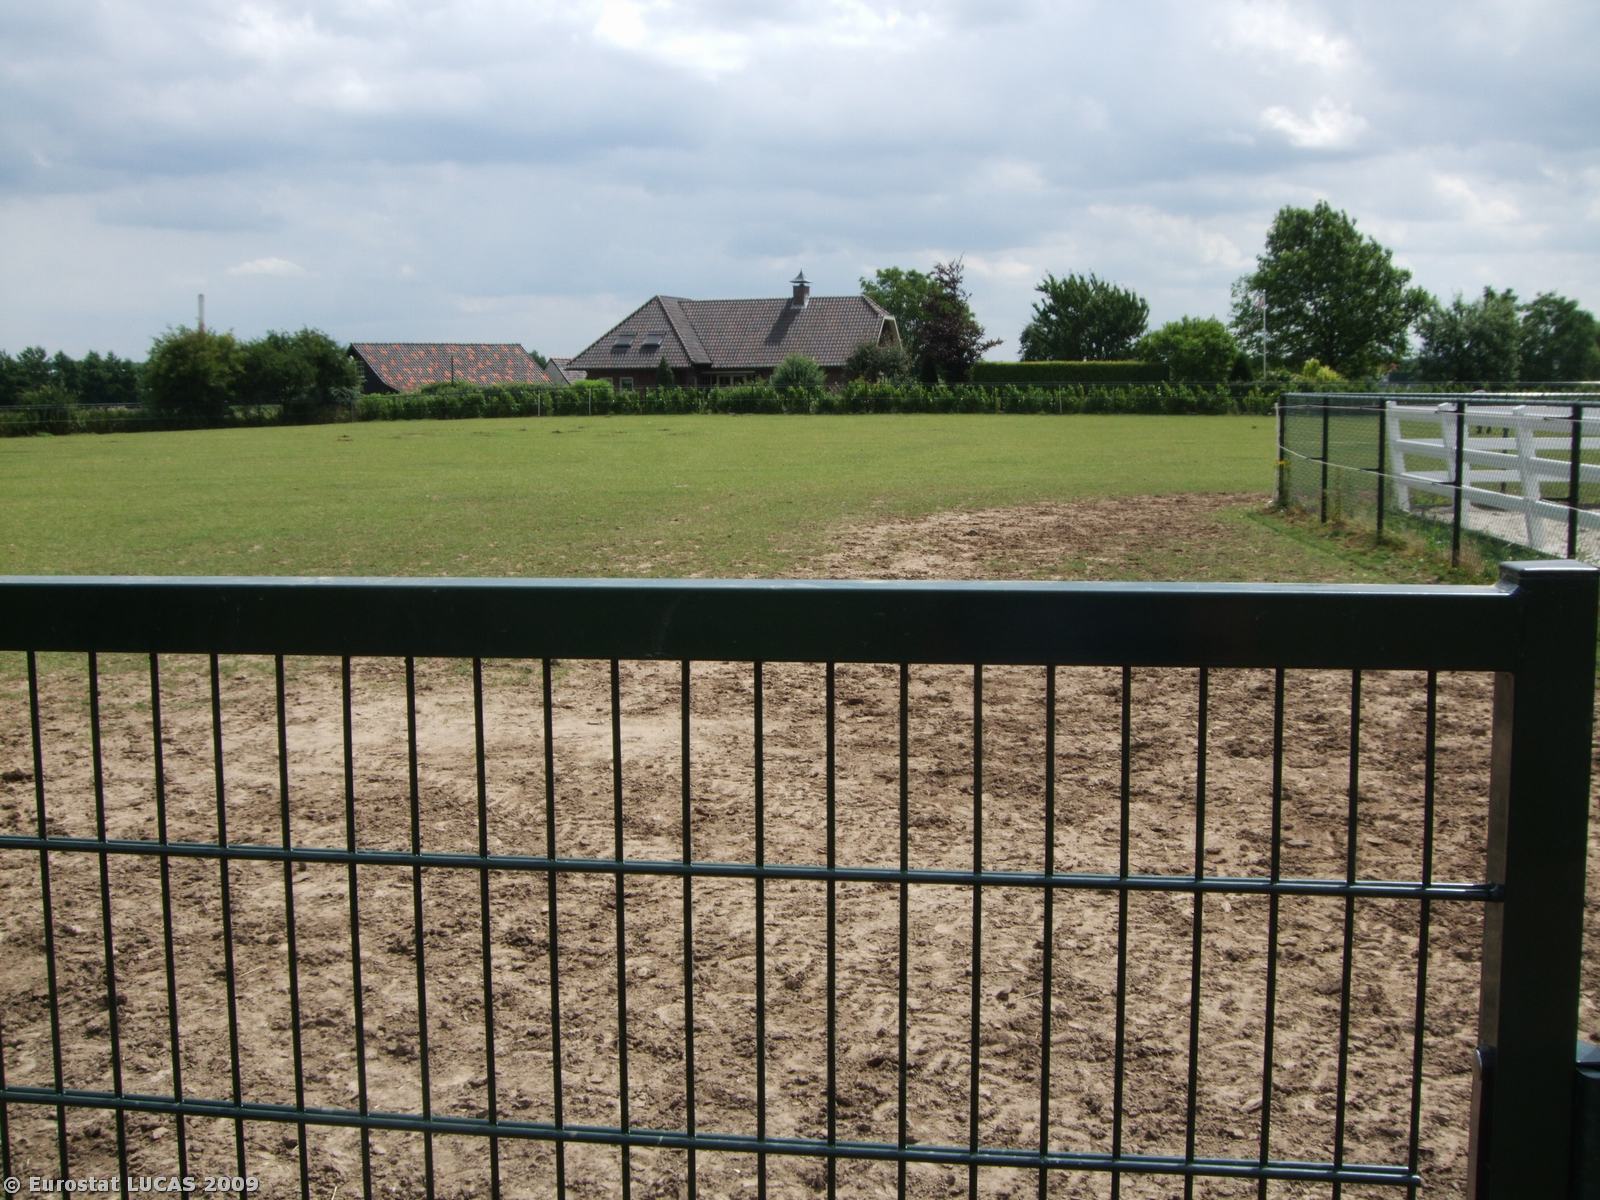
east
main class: Cropland
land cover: Apple fruit
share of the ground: 25 - 50 %
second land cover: Grassland with sparse tree/shrub cover
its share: 50 - 75 %
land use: Agriculture (excluding fallow land and kitchen gardens)
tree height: < 5 m
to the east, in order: Apple fruit; Fences; Grassland without tree/shrub cover; Fences; Ditches and canals; Abandoned hedges; Grassland without tree/shrub cover; Inland running water; Grassland without tree/shrub cover
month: July
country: NL
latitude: 51.9110
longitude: 5.4190
